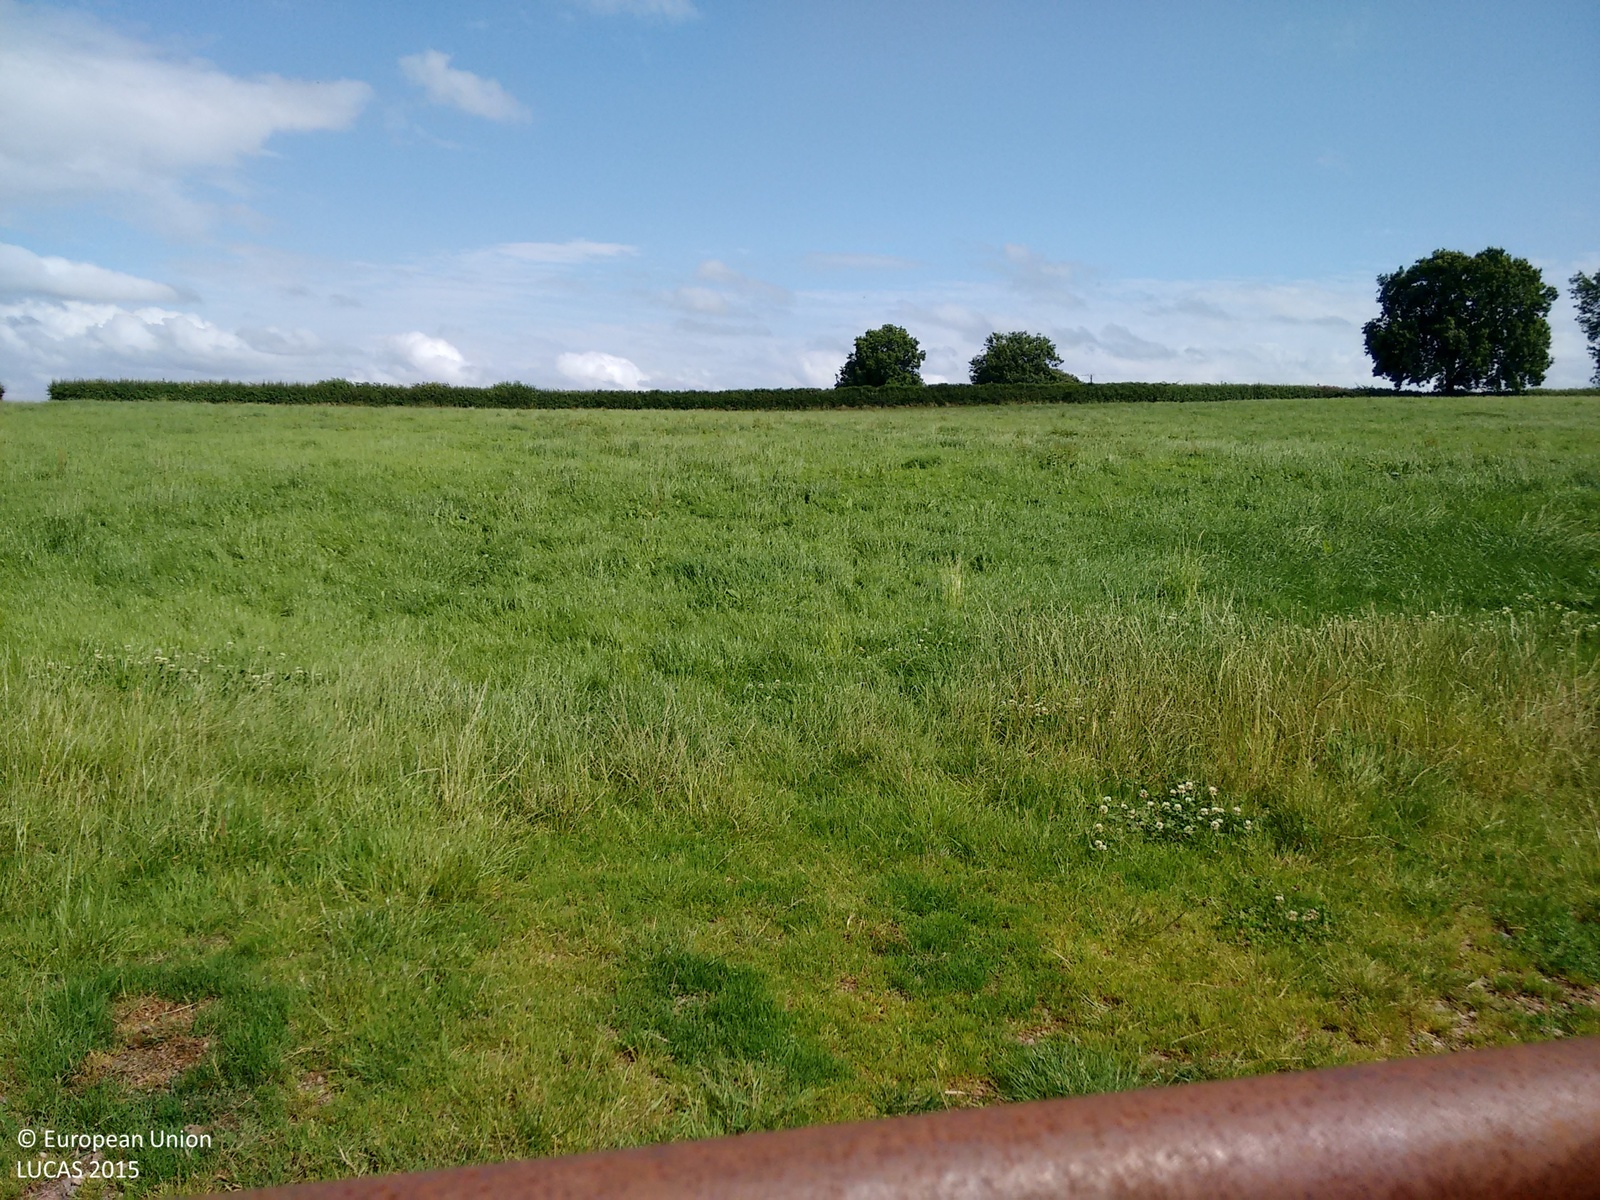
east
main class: Grassland
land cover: Grassland without tree/shrub cover
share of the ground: > 75 %
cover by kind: herbaceous plants 100 %
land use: Agriculture (excluding fallow land and kitchen gardens)
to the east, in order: Grassland without tree/shrub cover; Fences; Managed hedges; Fences; Grassland without tree/shrub cover; Electric lines; Grassland without tree/shrub cover; Fences; Managed hedges; Fences; Grassland without tree/shrub cover
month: July
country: GB
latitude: 51.2565
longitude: -2.5187
